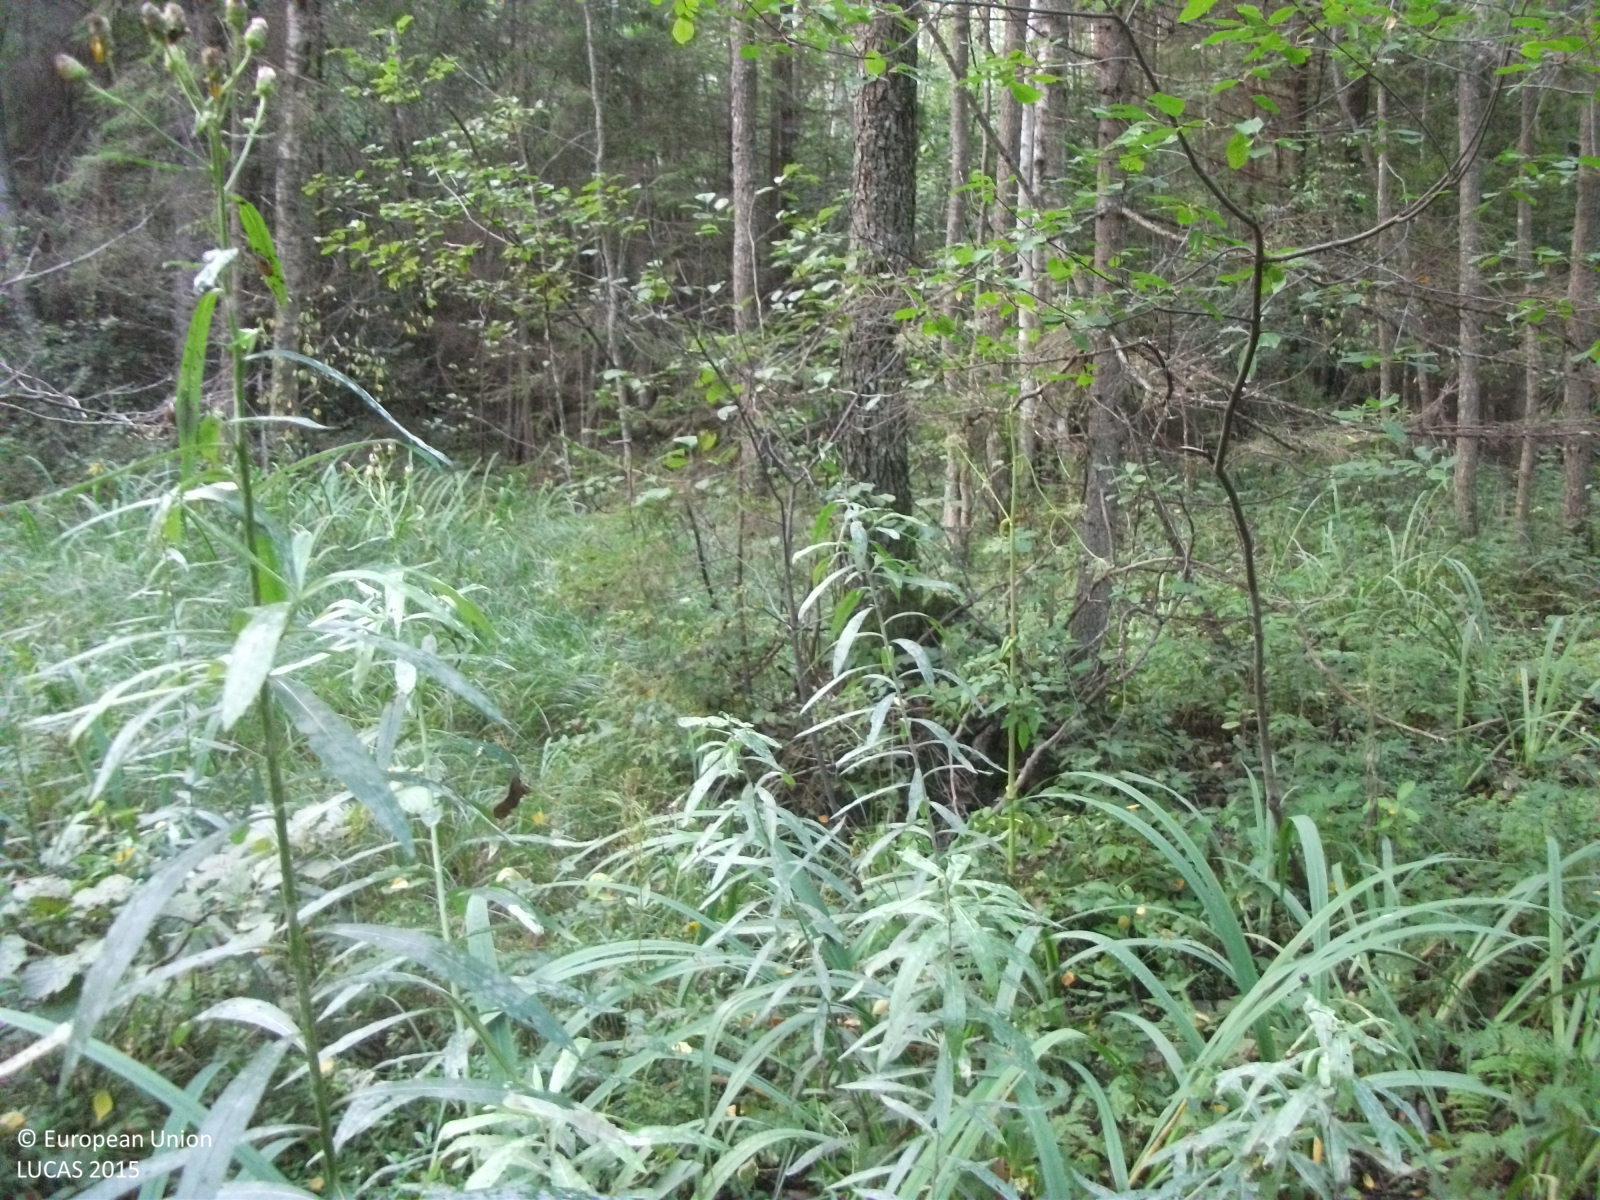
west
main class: Woodland
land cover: Other mixed woodland
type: hemiboreal forest and nemoral coniferous forest and mixed broadleaved-coniferous forest
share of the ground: 50 - 75 %
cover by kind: broadleaved forest trees 50 %, coniferous forest trees 20 %, herbaceous plants 20 %, shrubs 5 %, lichens and mosses 5 %
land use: Forestry
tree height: > 5 m
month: September
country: LV
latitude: 57.5683
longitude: 24.3824
